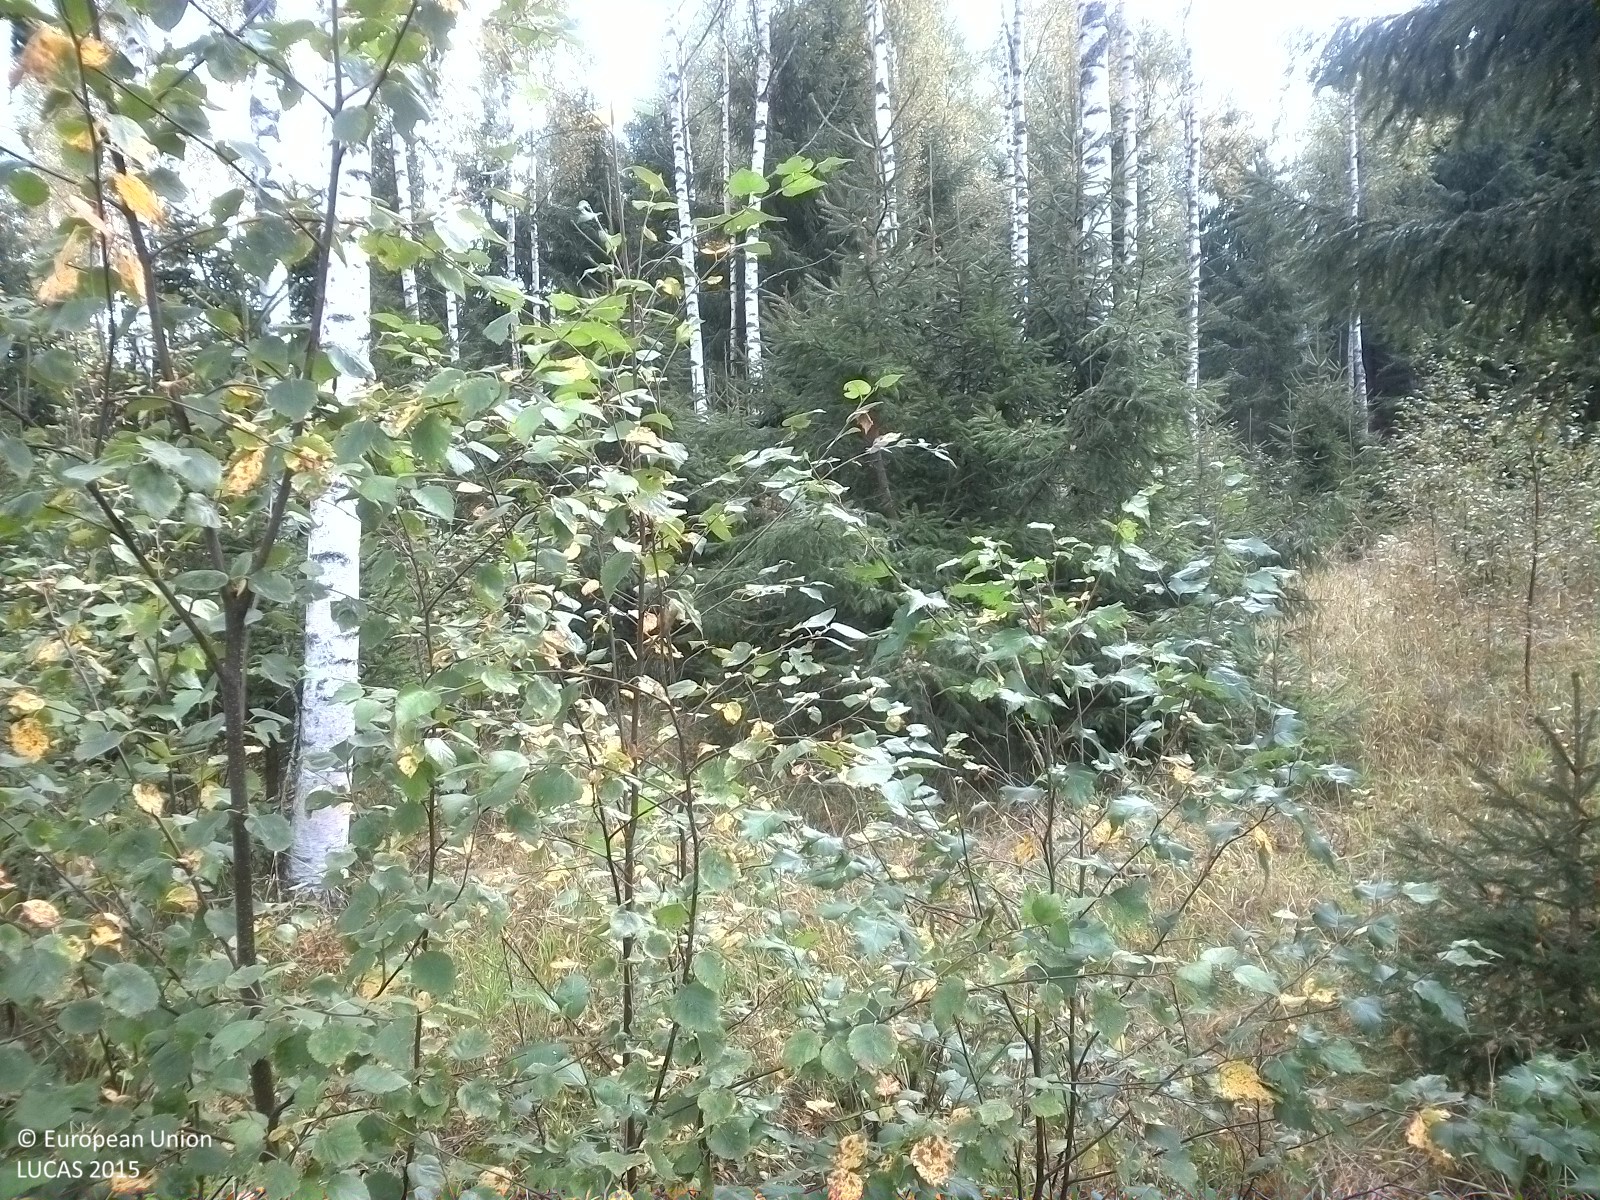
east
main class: Woodland
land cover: Spruce dominated mixed woodland
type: boreal forest
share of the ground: 50 - 75 %
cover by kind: herbaceous plants 35 %, coniferous forest trees 30 %, broadleaved forest trees 30 %, lichens and mosses 5 %
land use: Forestry
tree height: > 5 m
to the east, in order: Spruce dominated mixed woodland; Spruce dominated coniferous woodland; Ditches and canals; Spruce dominated mixed woodland; Spruce dominated coniferous woodland; Spruce dominated mixed woodland; Pine dominated coniferous woodland
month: August
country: SE
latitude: 58.6849
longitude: 15.0130
